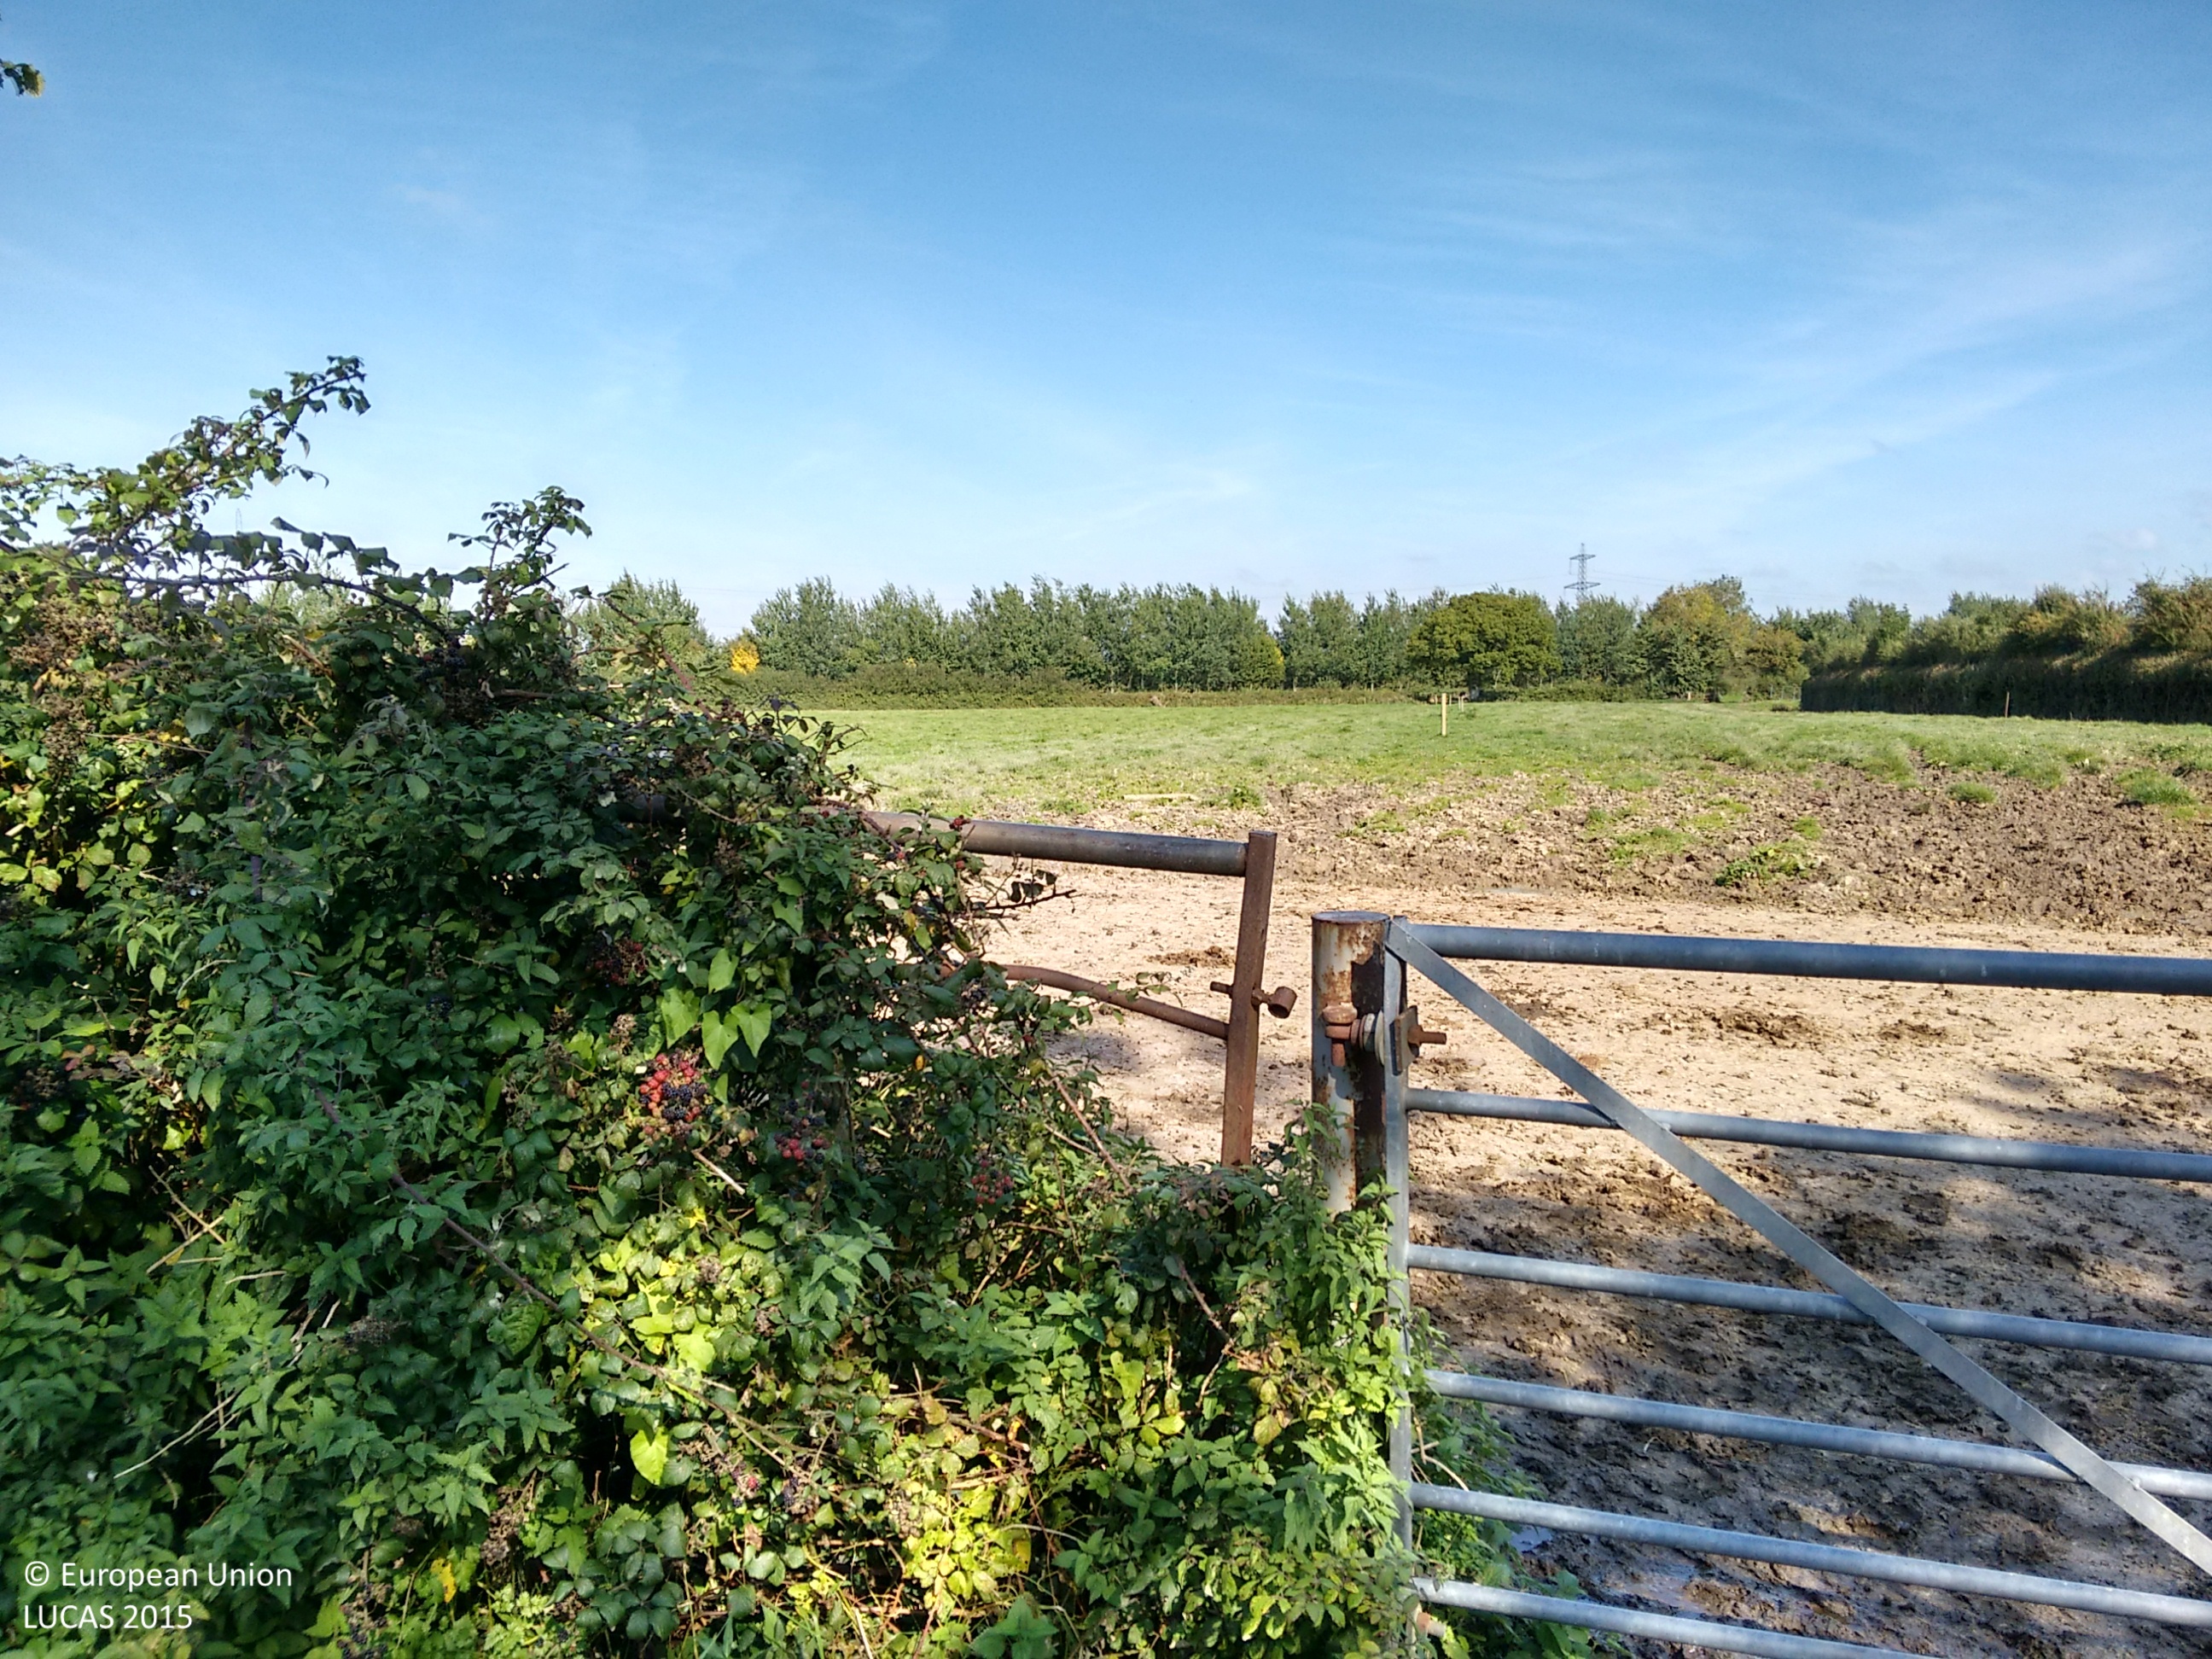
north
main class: Grassland
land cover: Grassland without tree/shrub cover
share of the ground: > 75 %
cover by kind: herbaceous plants 100 %
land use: Agriculture (excluding fallow land and kitchen gardens)
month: September
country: GB
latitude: 51.5745
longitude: -2.6072
